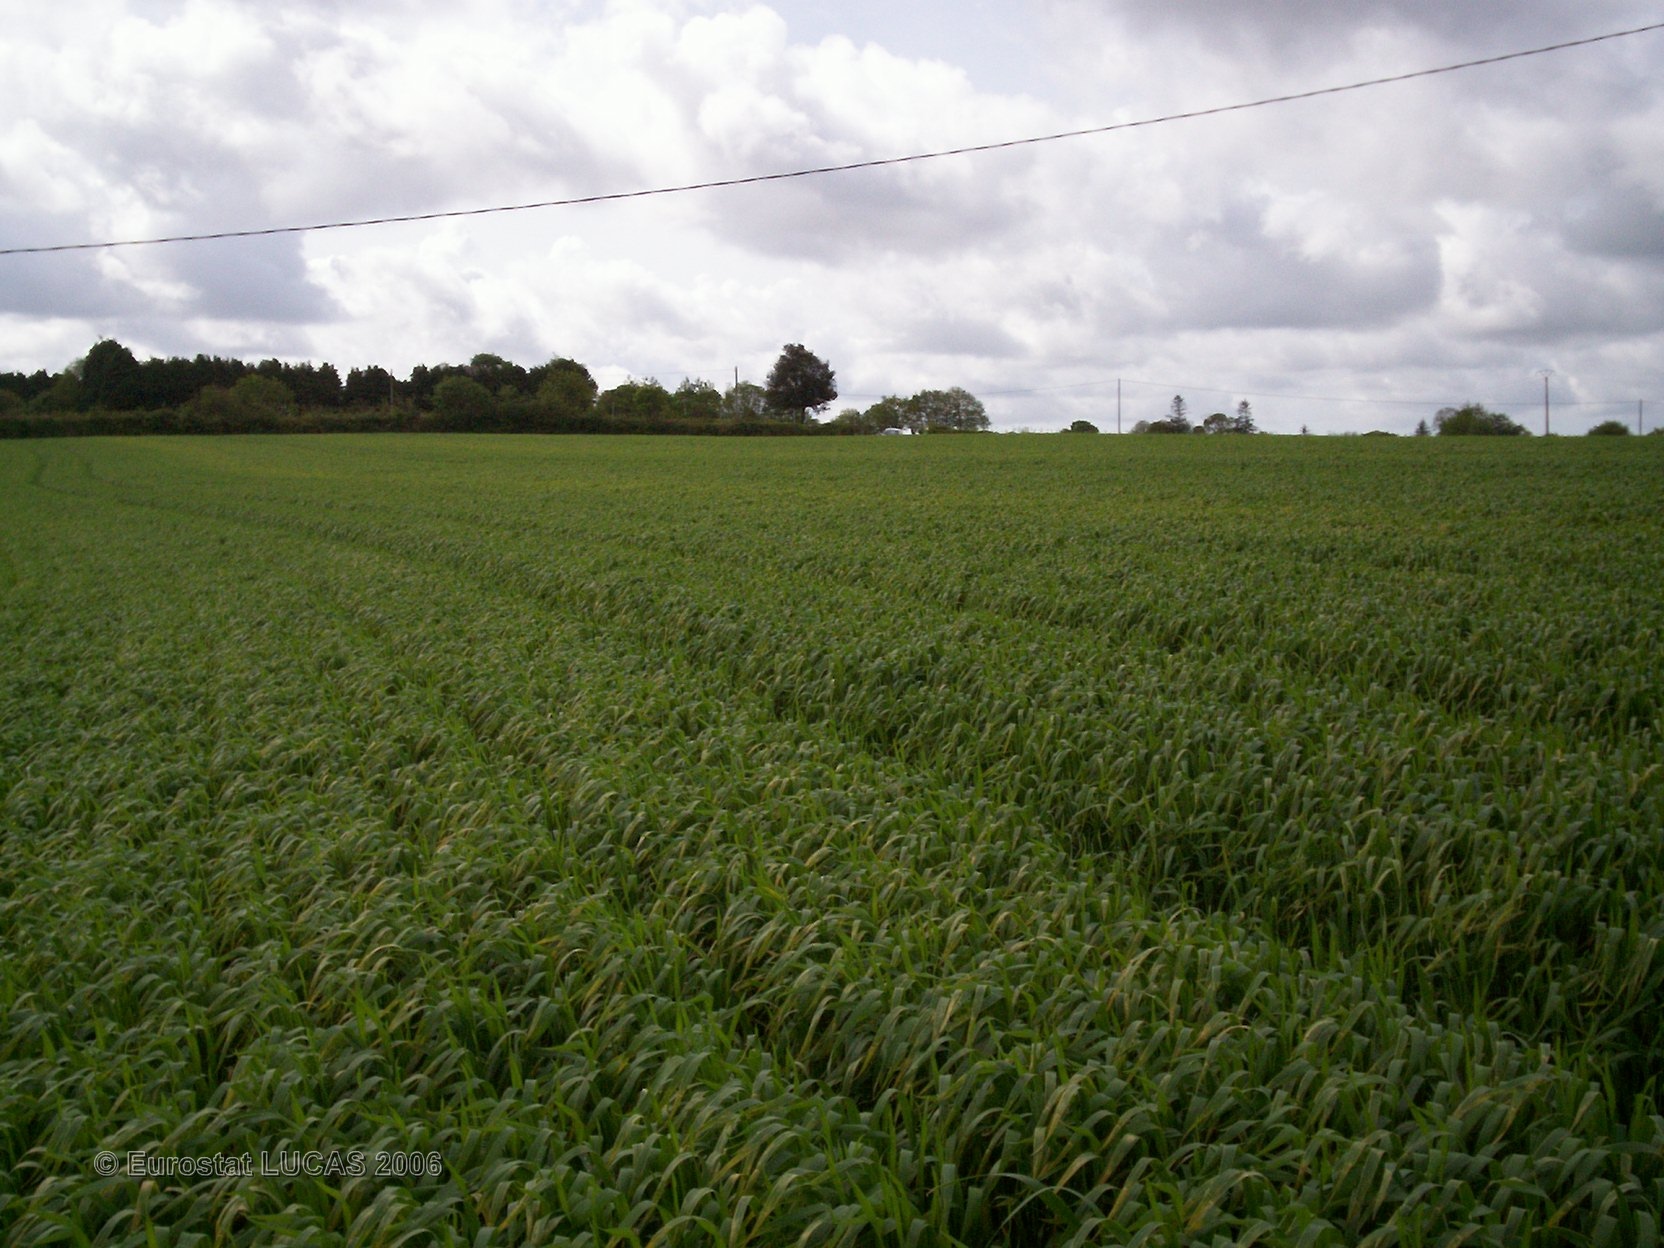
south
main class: Cropland
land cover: Triticale
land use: Agriculture (excluding fallow land and kitchen gardens)
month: May
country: FR
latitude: 48.0476
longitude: -3.9156
